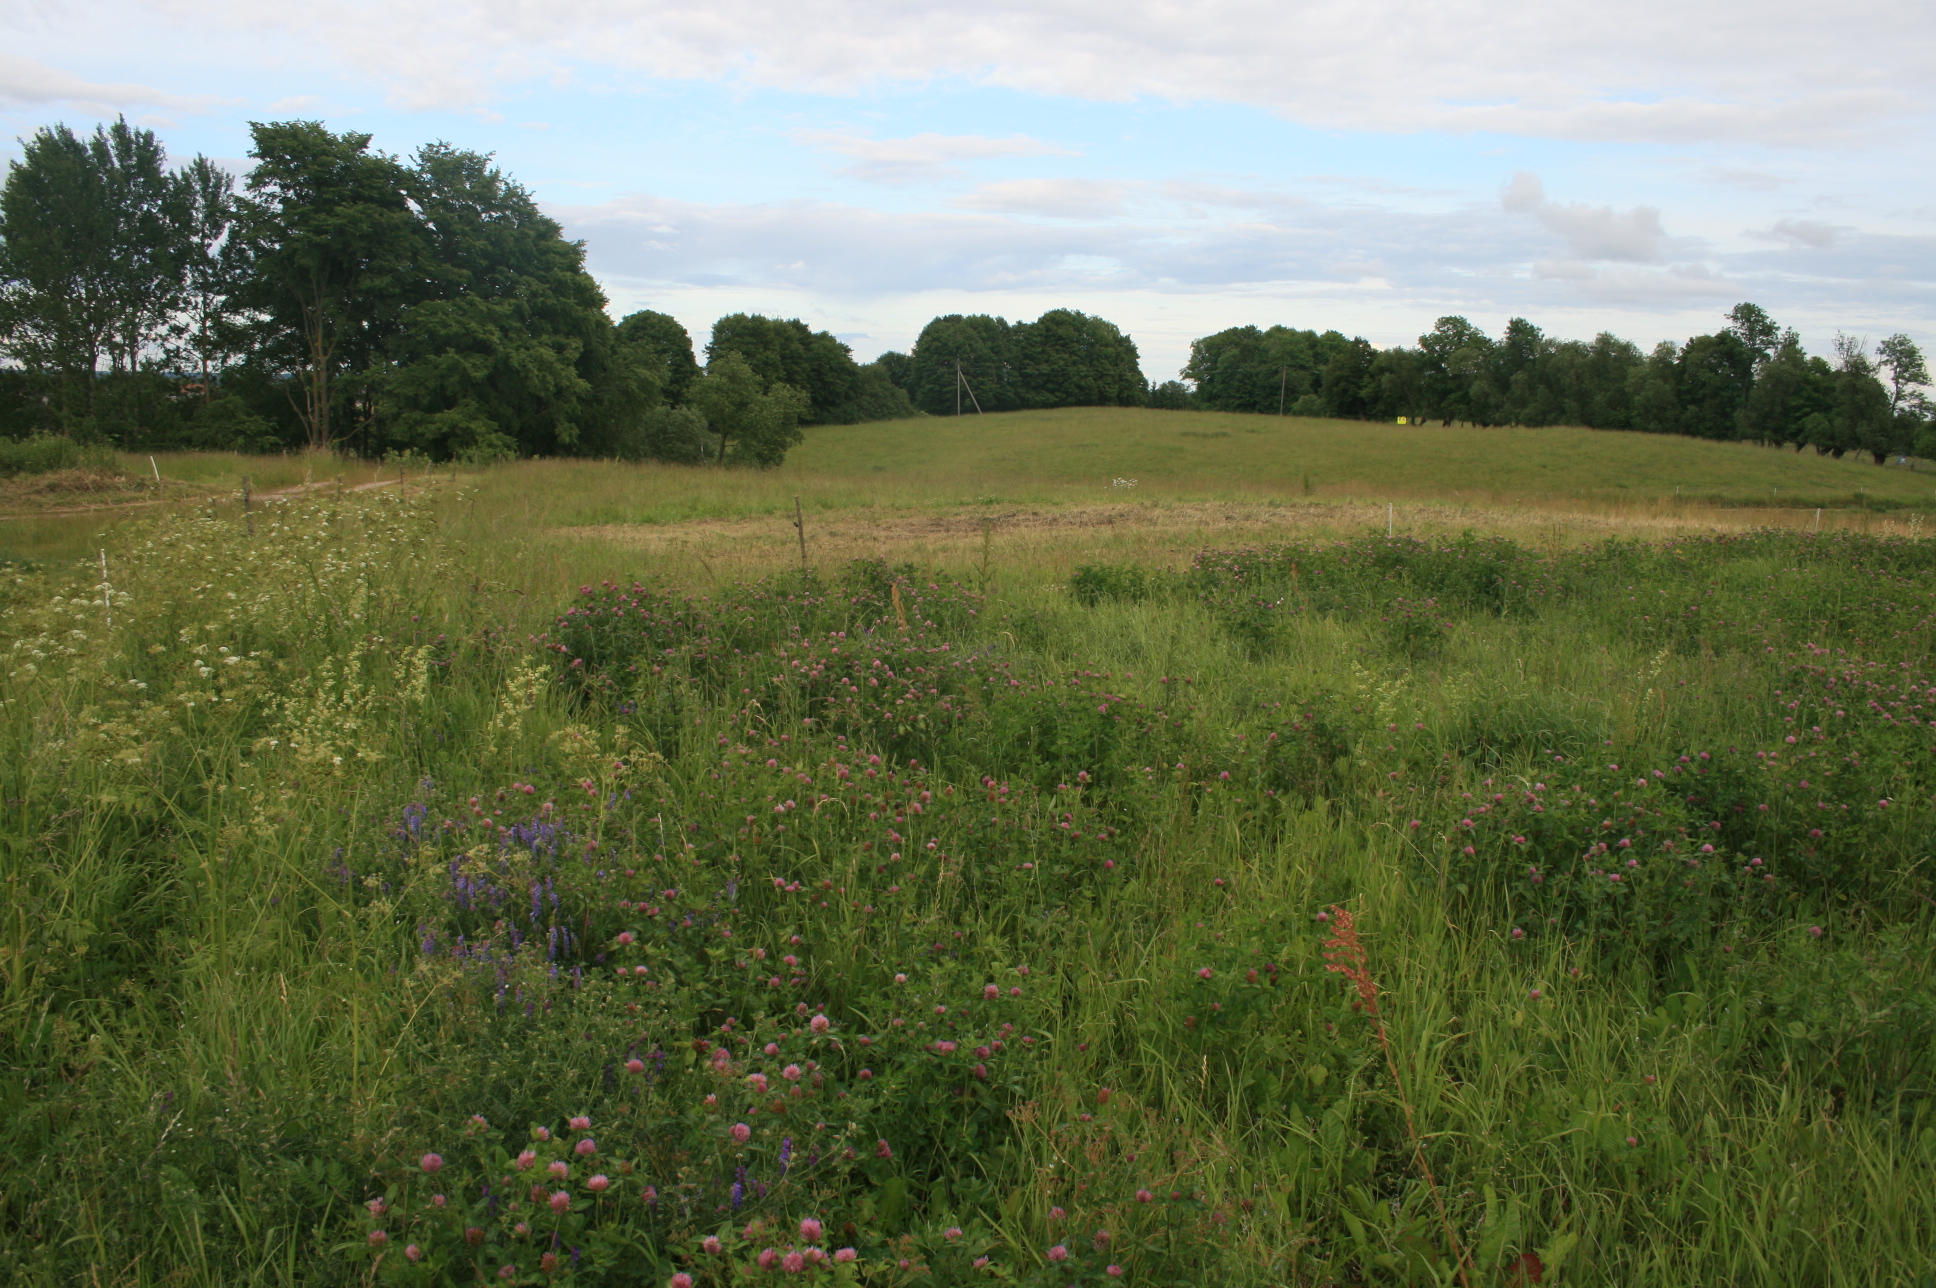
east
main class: Grassland
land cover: Grassland without tree/shrub cover
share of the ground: > 75 %
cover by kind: herbaceous plants 100 %
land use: Agriculture (excluding fallow land and kitchen gardens)
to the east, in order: Grassland without tree/shrub cover; Fences; Grassland without tree/shrub cover; Tracks; Abandoned hedges; Grassland without tree/shrub cover; Broadleaved woodland; Paved roads, cycling and walking lanes; Fences; Broadleaved woodland; Grassland without tree/shrub cover; Fences; Broadleaved woodland
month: June
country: LT
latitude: 55.1199
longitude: 22.1138
